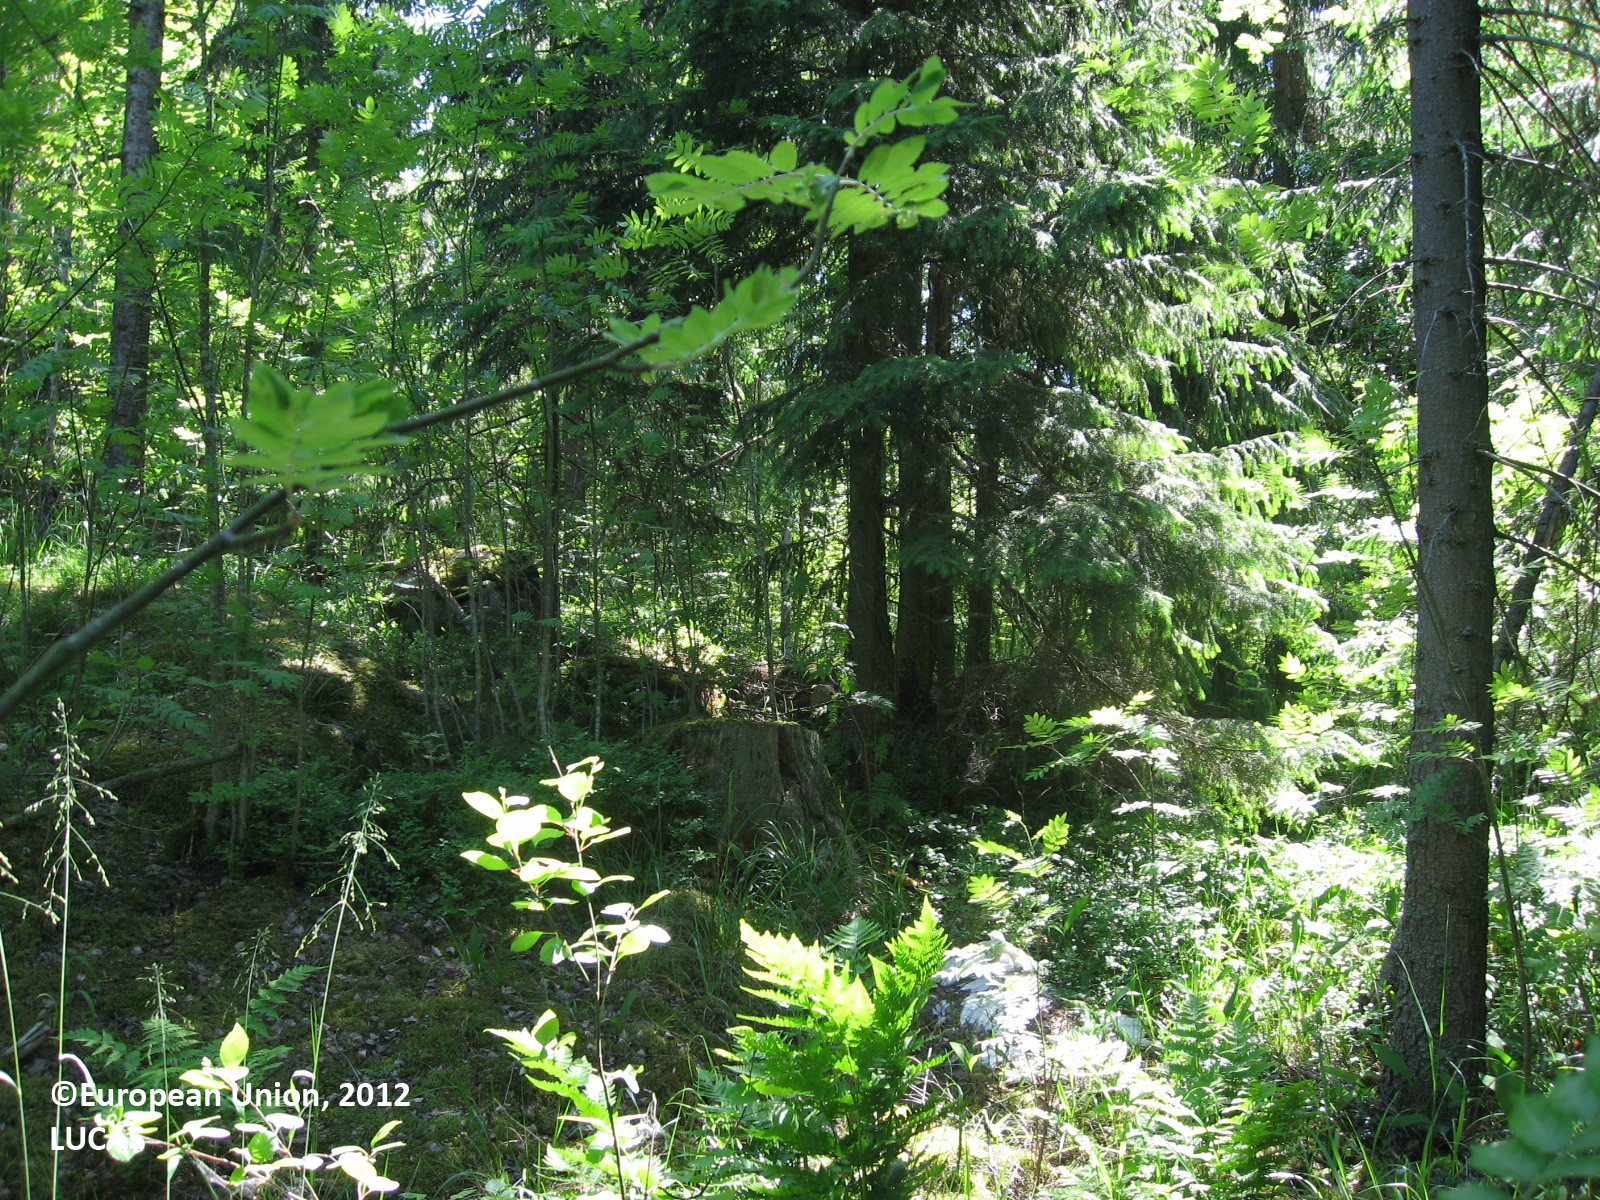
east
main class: Woodland
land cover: Spruce dominated mixed woodland
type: boreal forest
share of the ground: 50 - 75 %
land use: Forestry
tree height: > 5 m
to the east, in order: Spruce dominated mixed woodland; Artificial constructions in urban areas; Spruce dominated mixed woodland; Ditches and canals; Electric lines; Paved roads, cycling and walking lanes; Grass margins; Spruce dominated mixed woodland
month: June
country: FI
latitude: 60.5117
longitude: 24.9965
